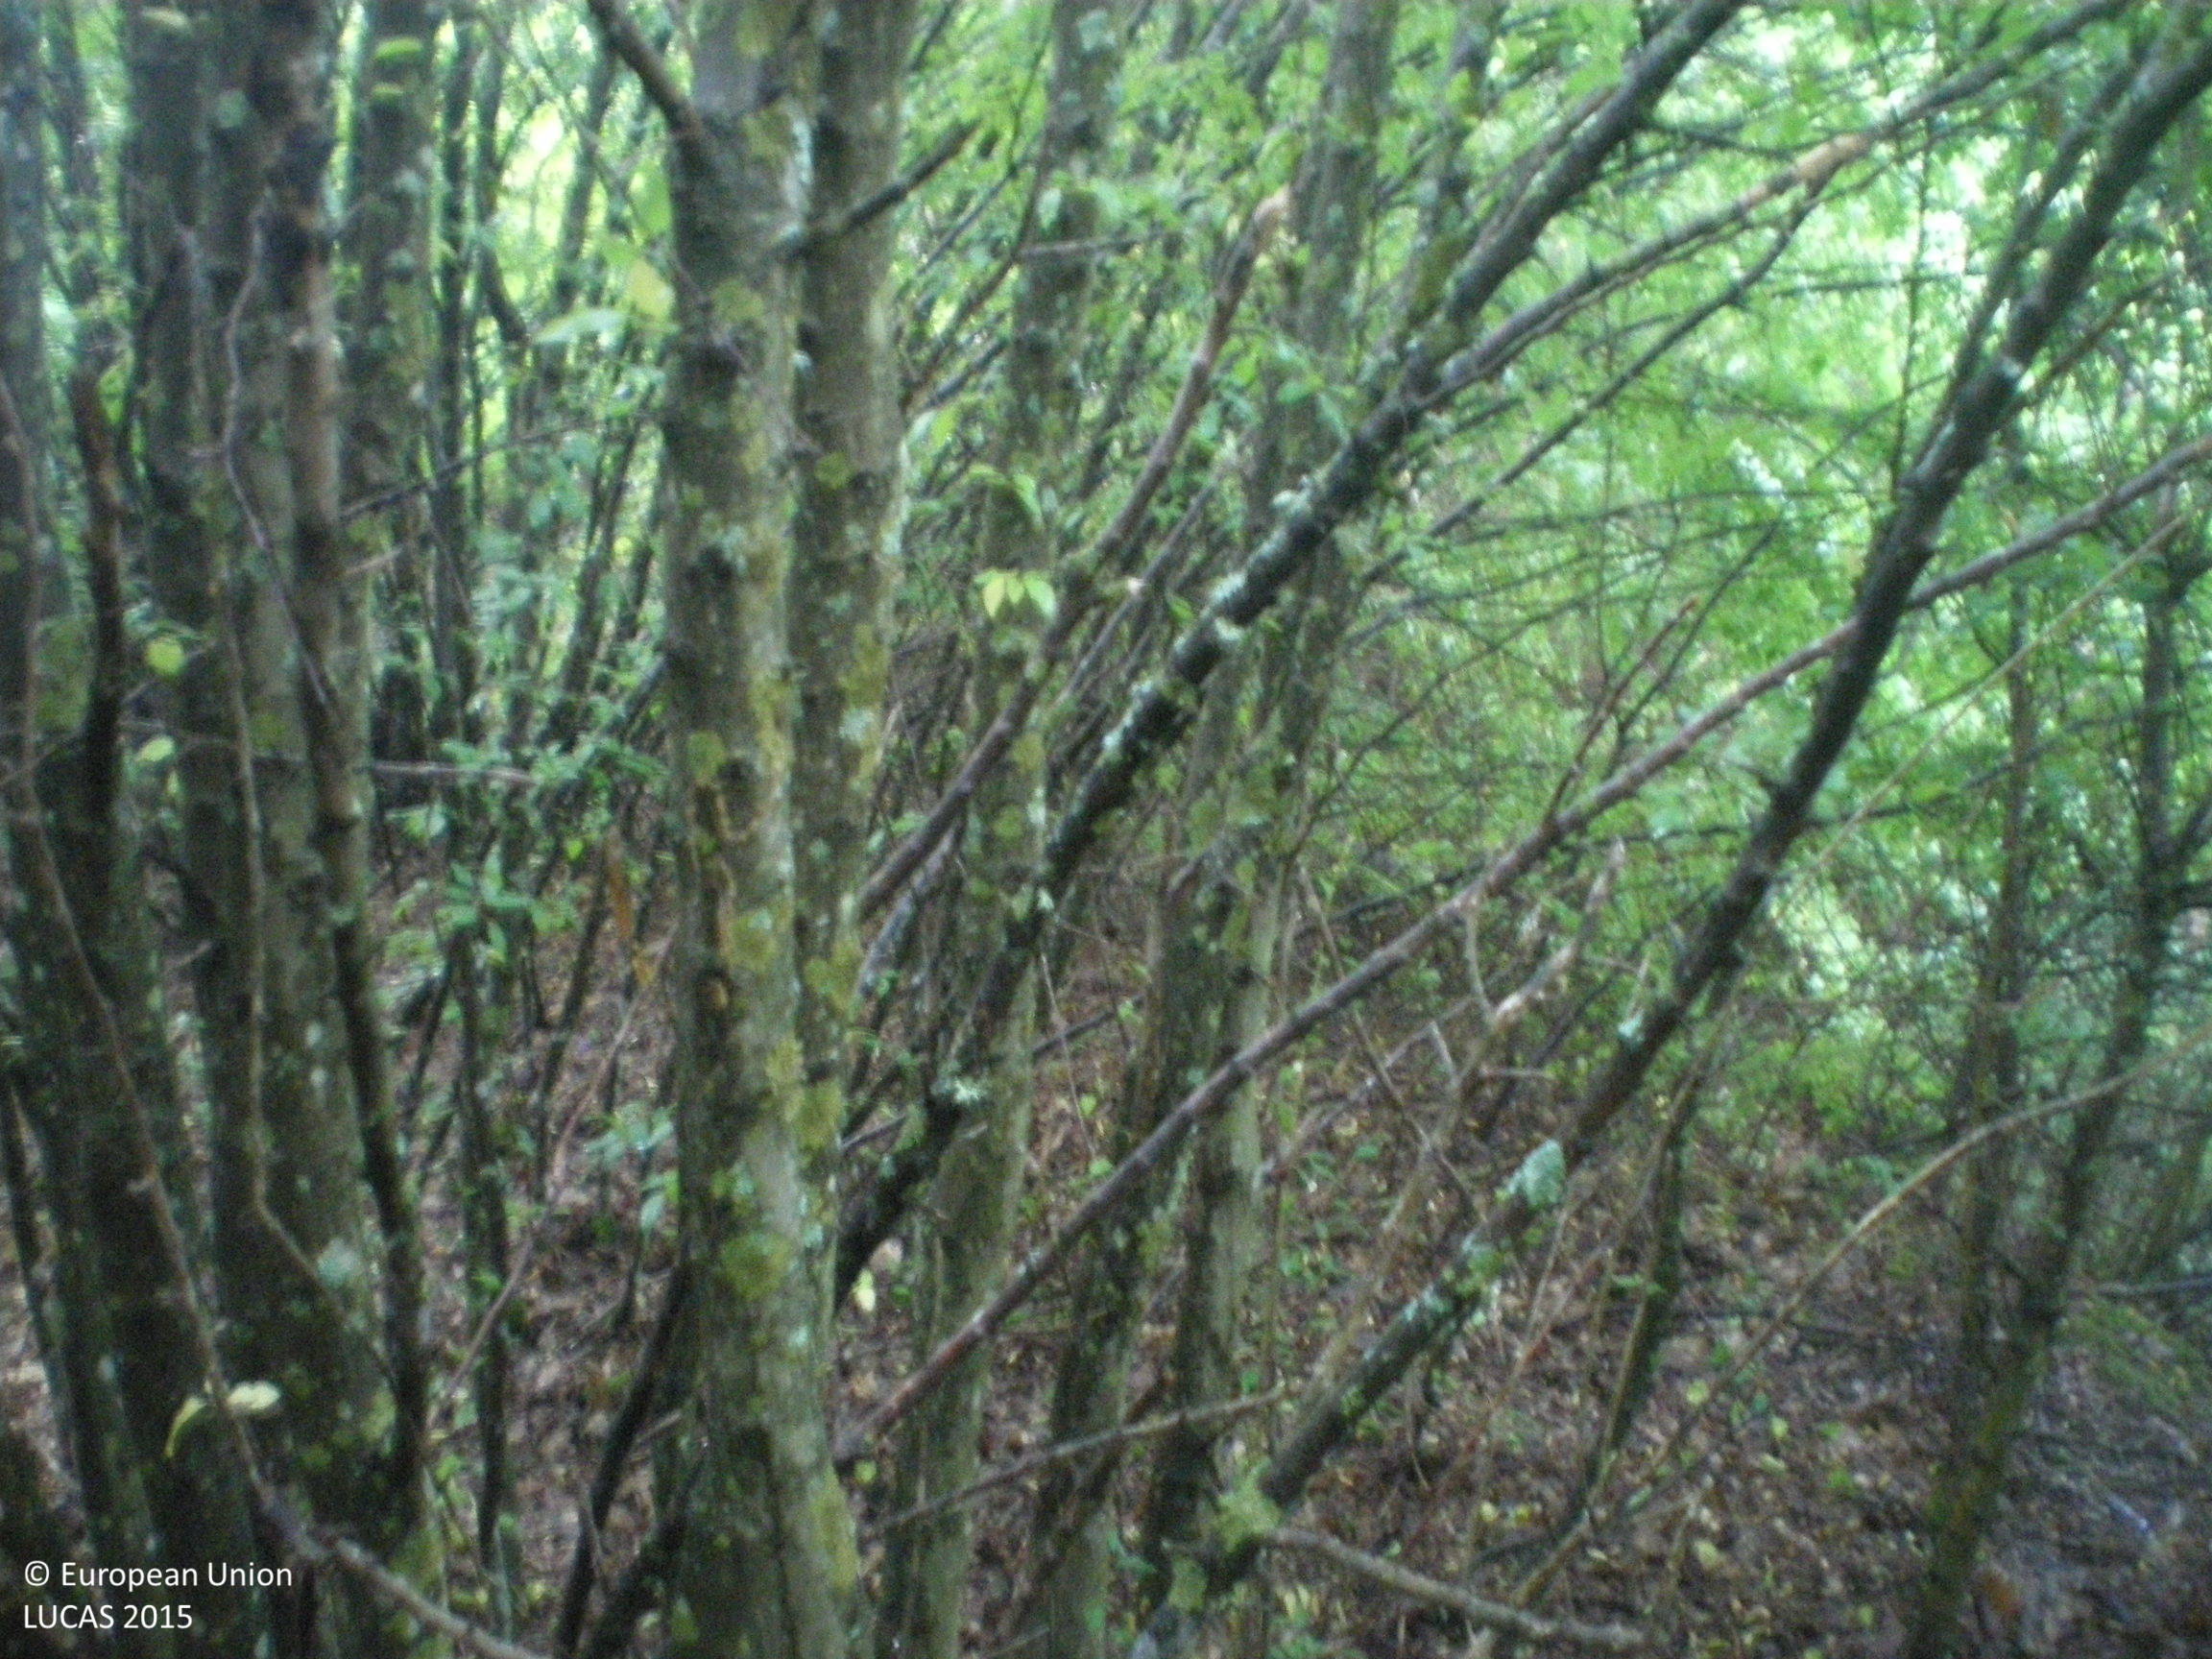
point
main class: Woodland
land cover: Broadleaved woodland
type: mesophytic deciduous forest
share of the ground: > 75 %
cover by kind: broadleaved forest trees 95 %, unconsolidated bare surface 5 %
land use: Forestry
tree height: > 5 m
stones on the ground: < 10 %
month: July
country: BG
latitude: 42.4241
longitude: 25.2690
